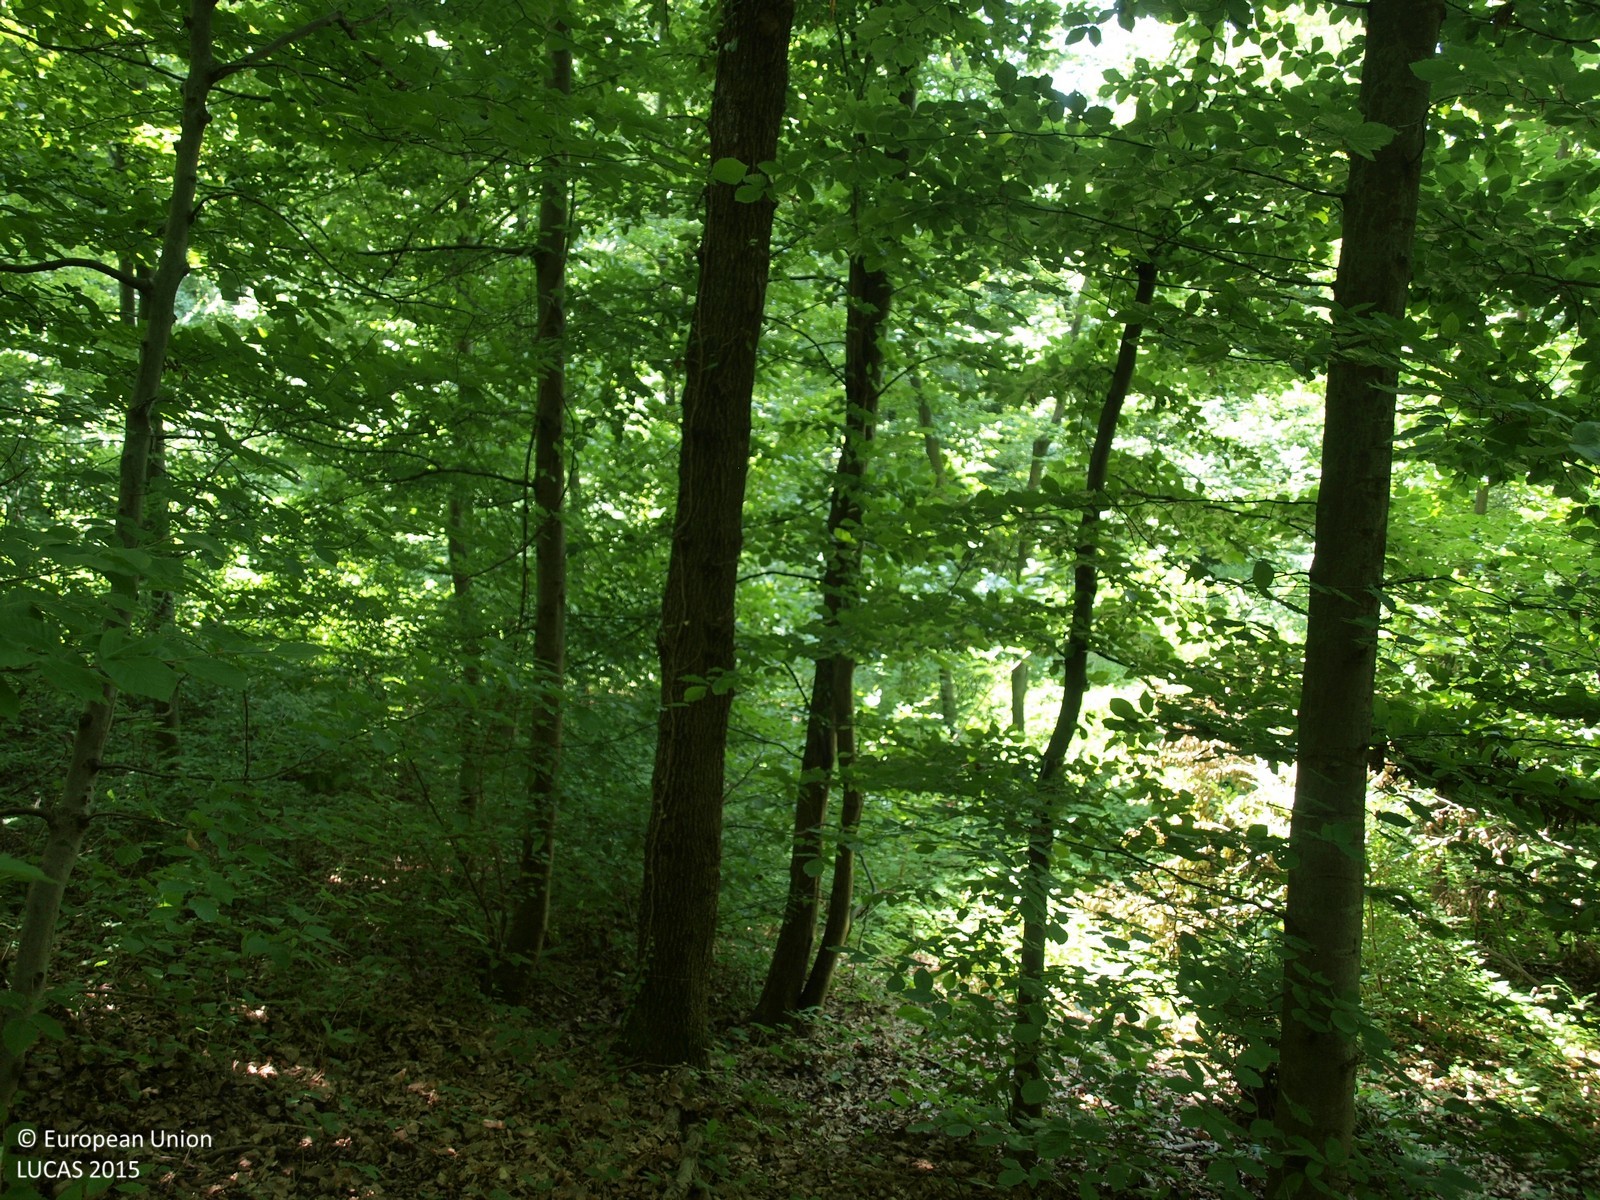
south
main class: Woodland
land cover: Broadleaved woodland
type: beech forest
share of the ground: > 75 %
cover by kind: broadleaved forest trees 100 %
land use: Forestry
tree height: > 5 m
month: July
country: HR
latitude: 45.7455
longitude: 15.7428
